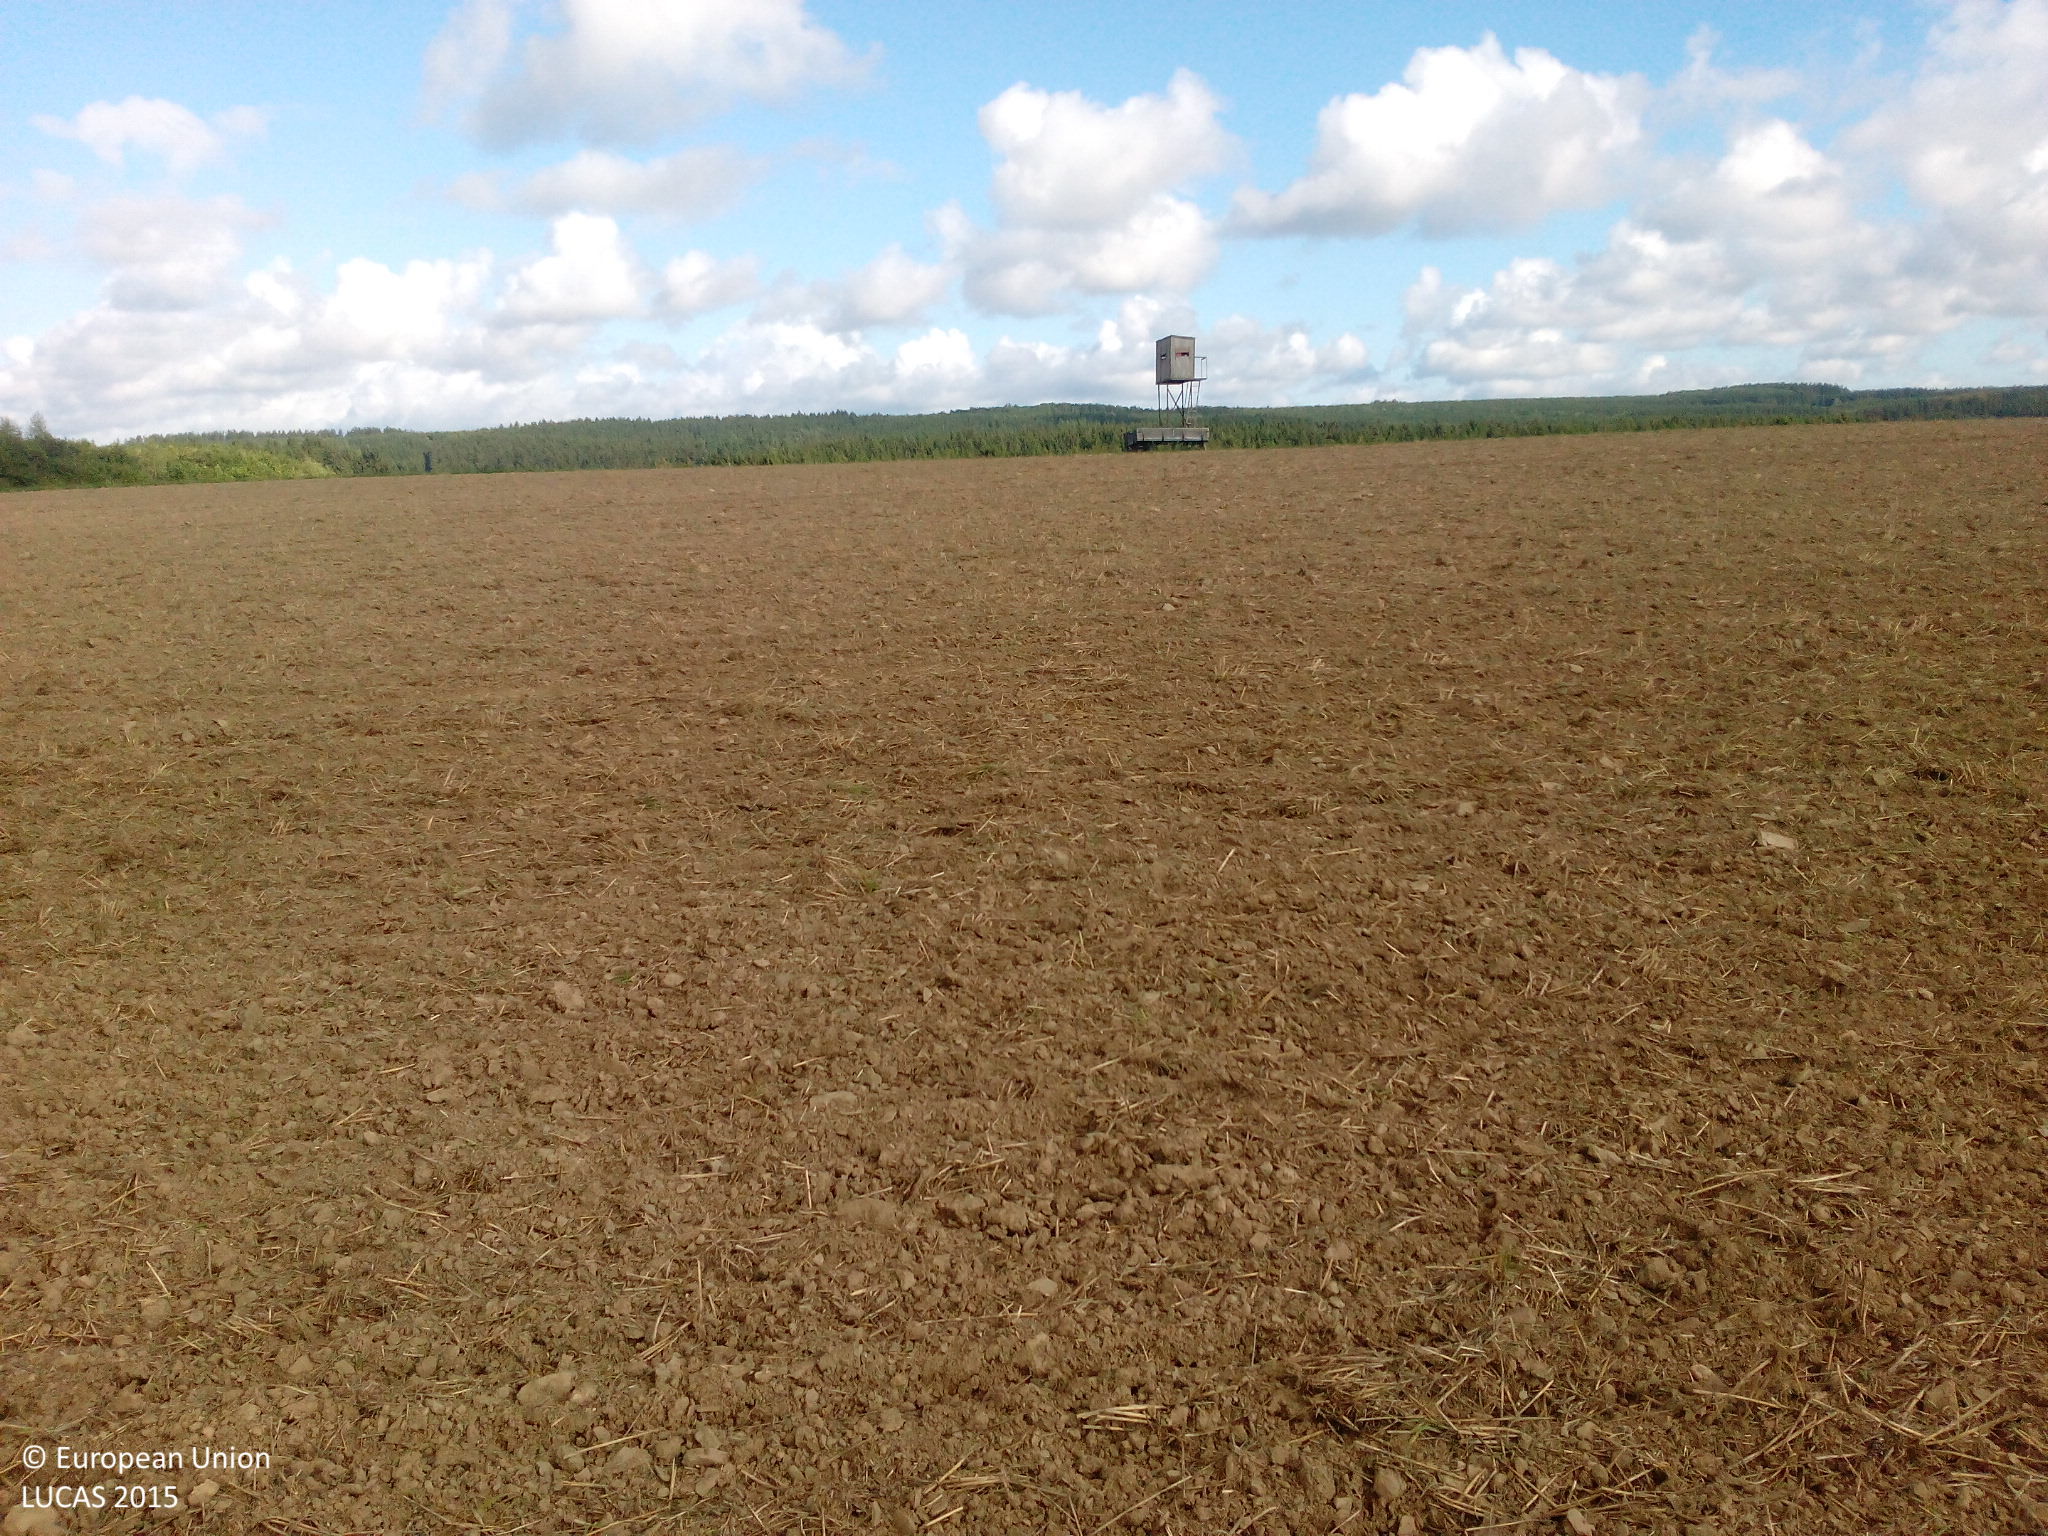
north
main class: Cropland
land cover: Common wheat
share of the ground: < 10 %
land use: Agriculture (excluding fallow land and kitchen gardens)
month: September
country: DE
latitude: 51.5816
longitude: 11.0820
